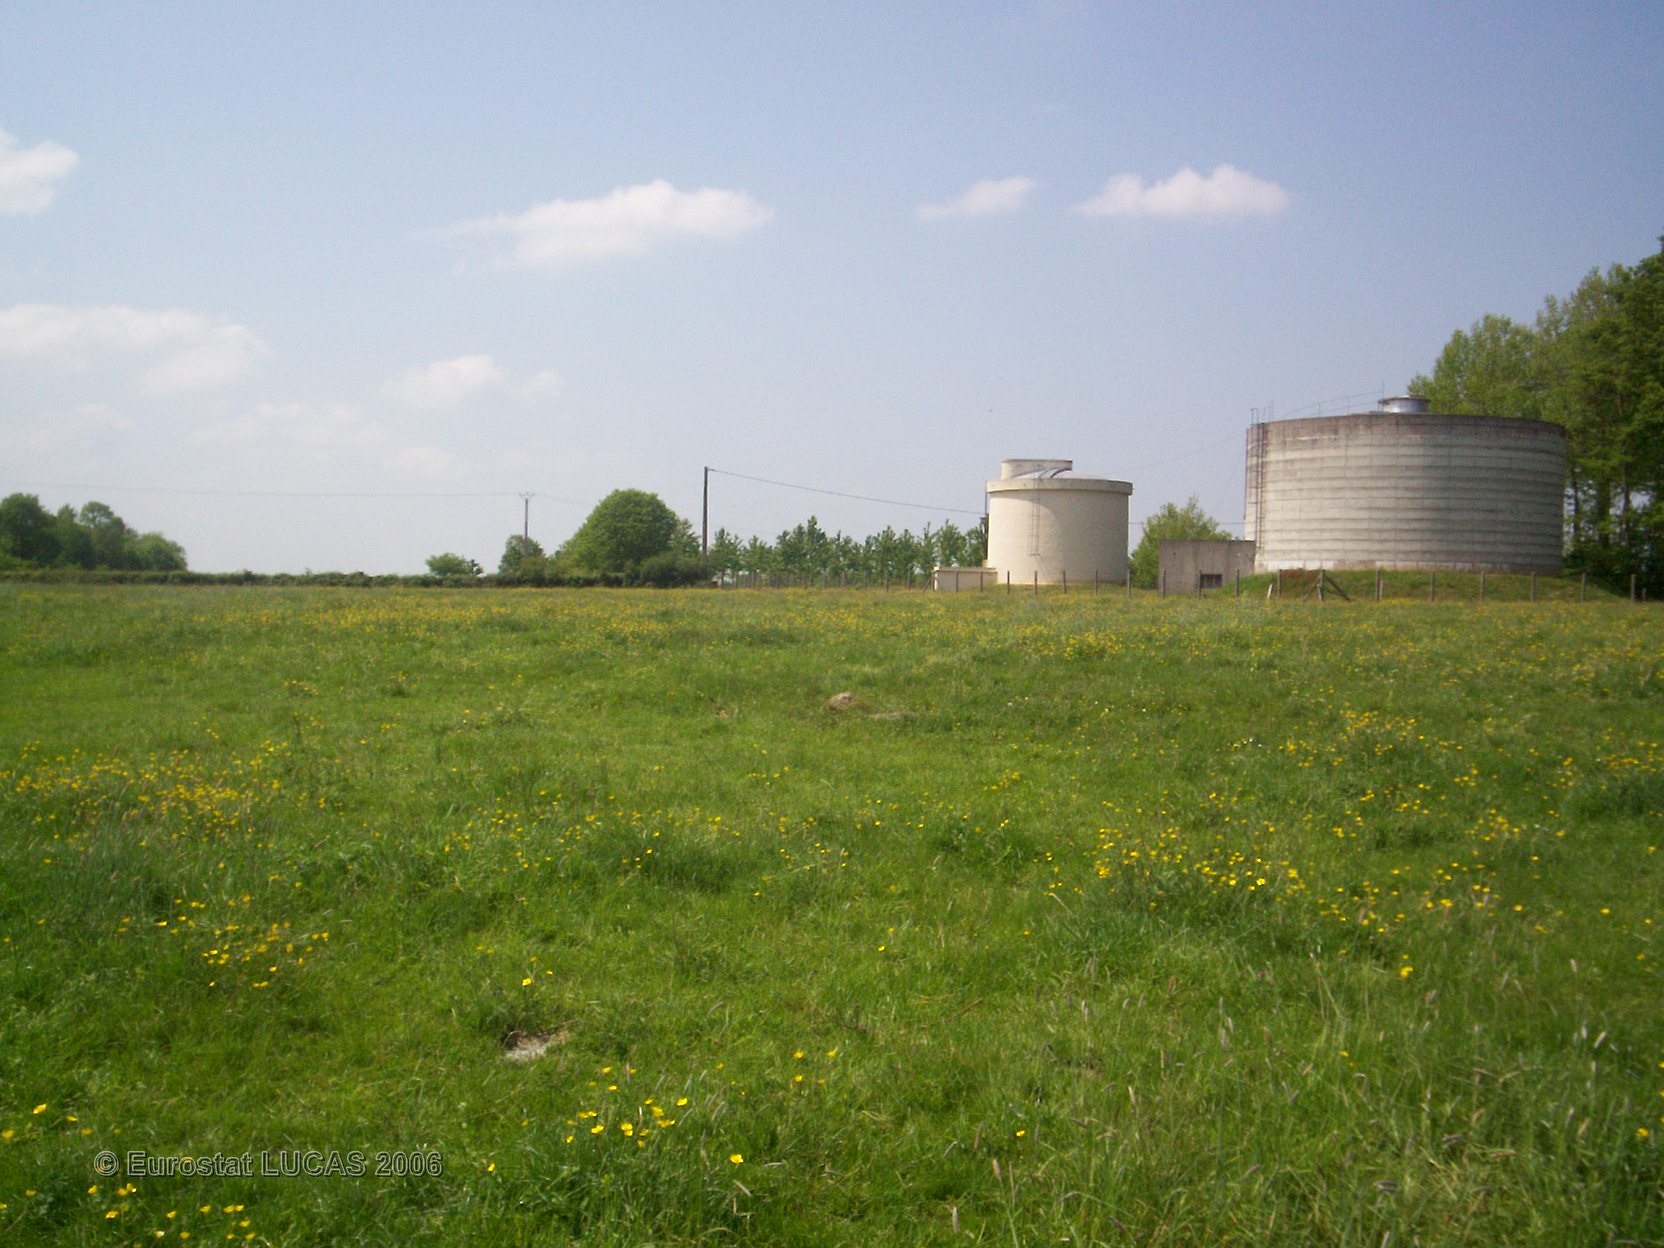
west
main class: Grassland
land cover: Grassland without tree/shrub cover
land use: Agriculture (excluding fallow land and kitchen gardens)
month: May
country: FR
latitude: 47.7471
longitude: 0.1714
